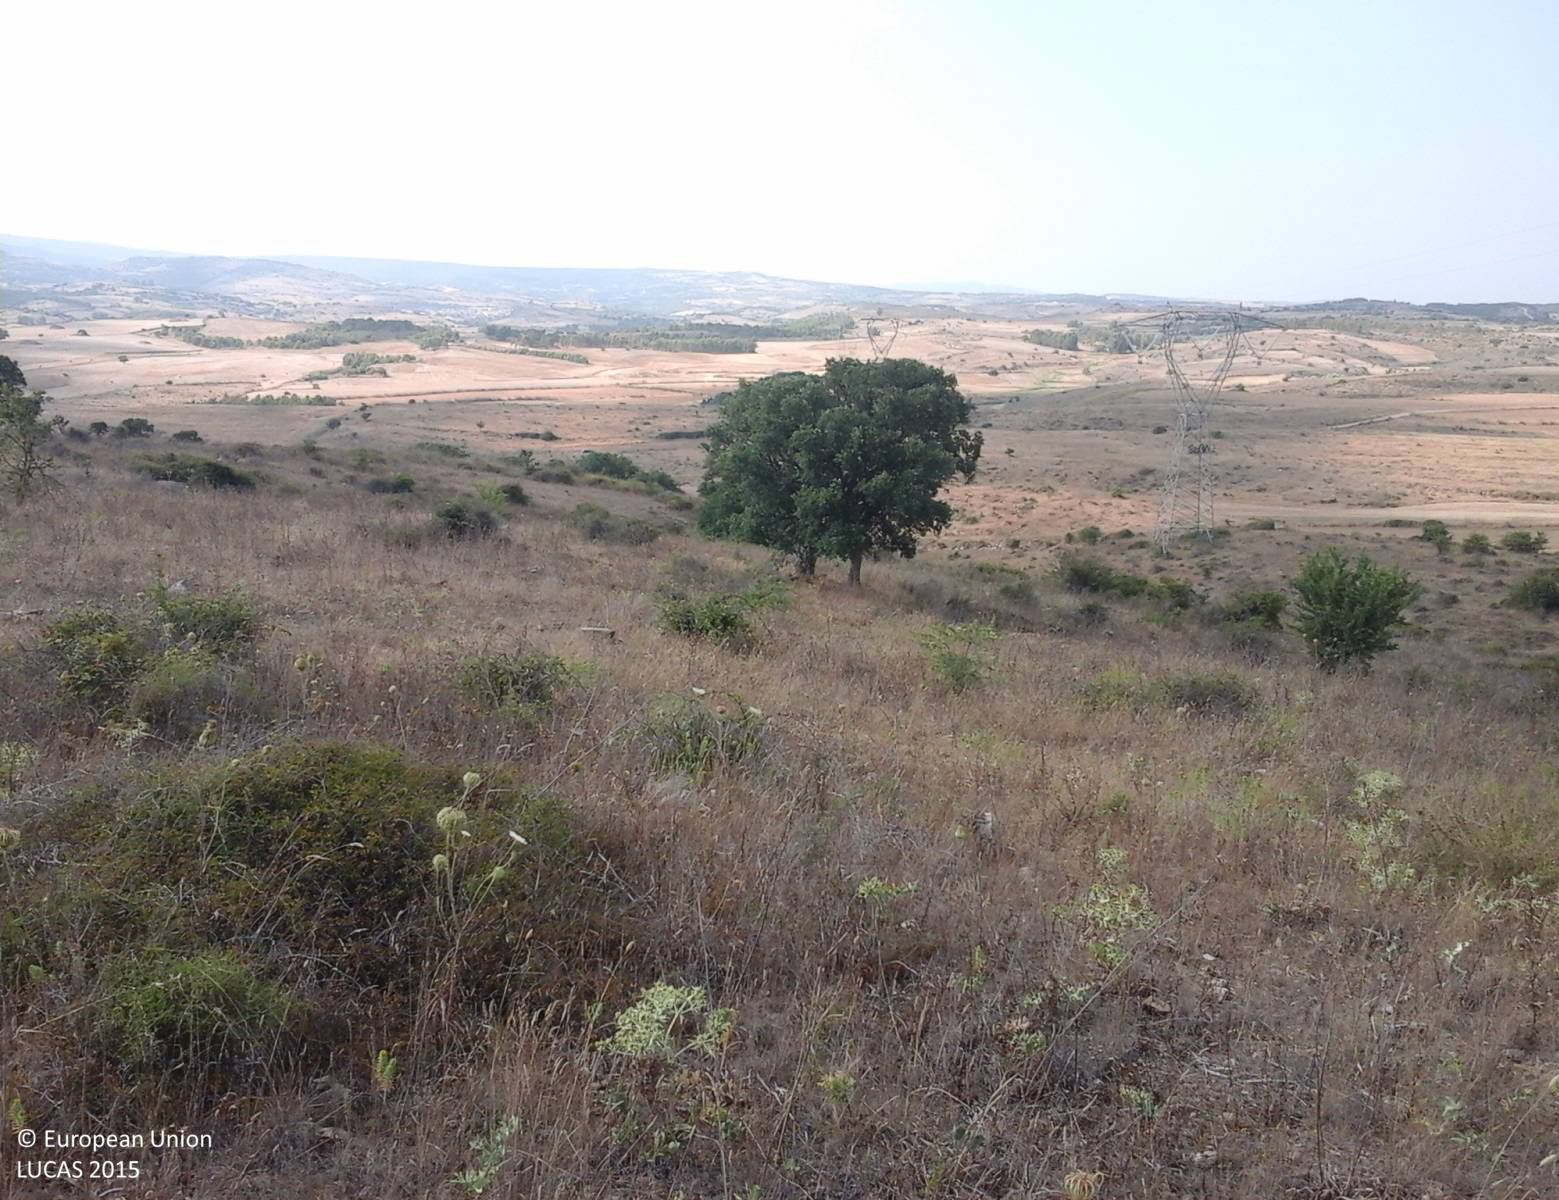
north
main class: Shrubland
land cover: Shrubland without tree cover
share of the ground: > 75 %
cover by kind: herbaceous plants 60 %, shrubs 40 %
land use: Semi-natural and natural areas not in use
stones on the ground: 10 - 25 %
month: July
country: IT
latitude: 39.7355
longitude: 8.8514
